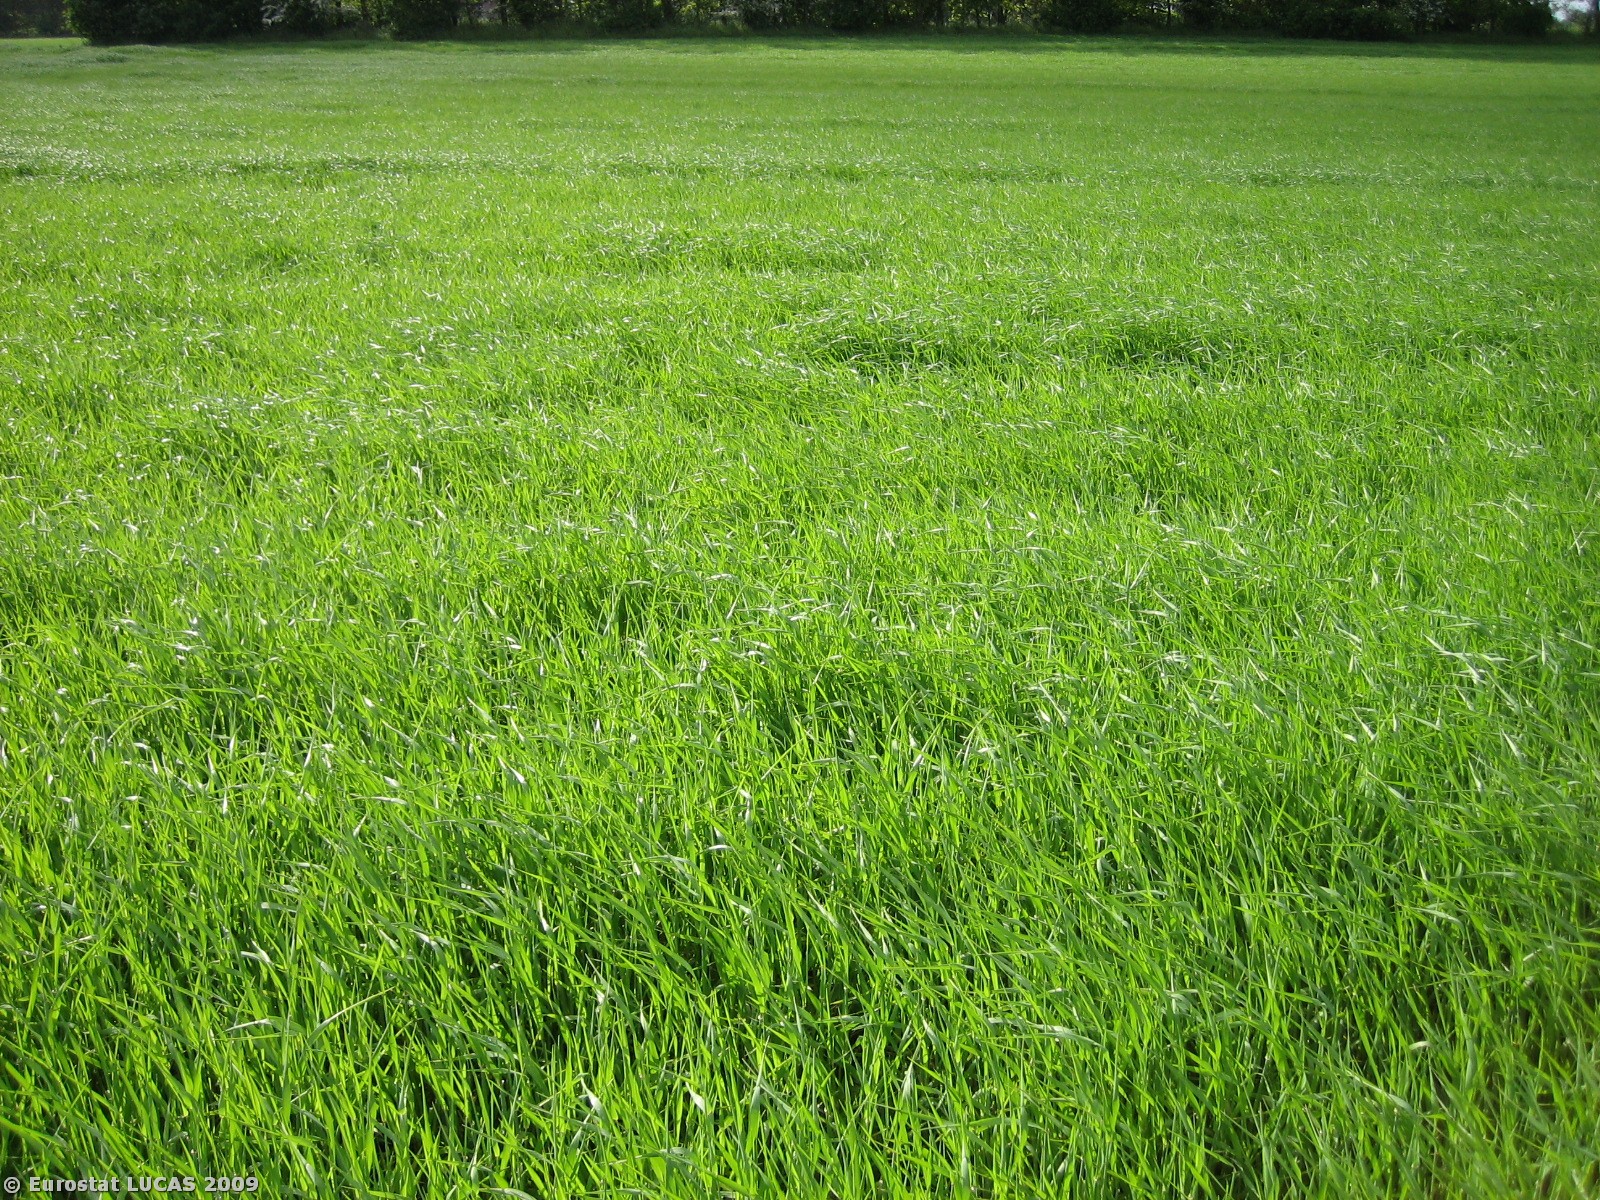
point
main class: Cropland
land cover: Barley
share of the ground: > 75 %
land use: Agriculture (excluding fallow land and kitchen gardens)
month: May
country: DK
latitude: 55.8977
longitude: 9.2172
